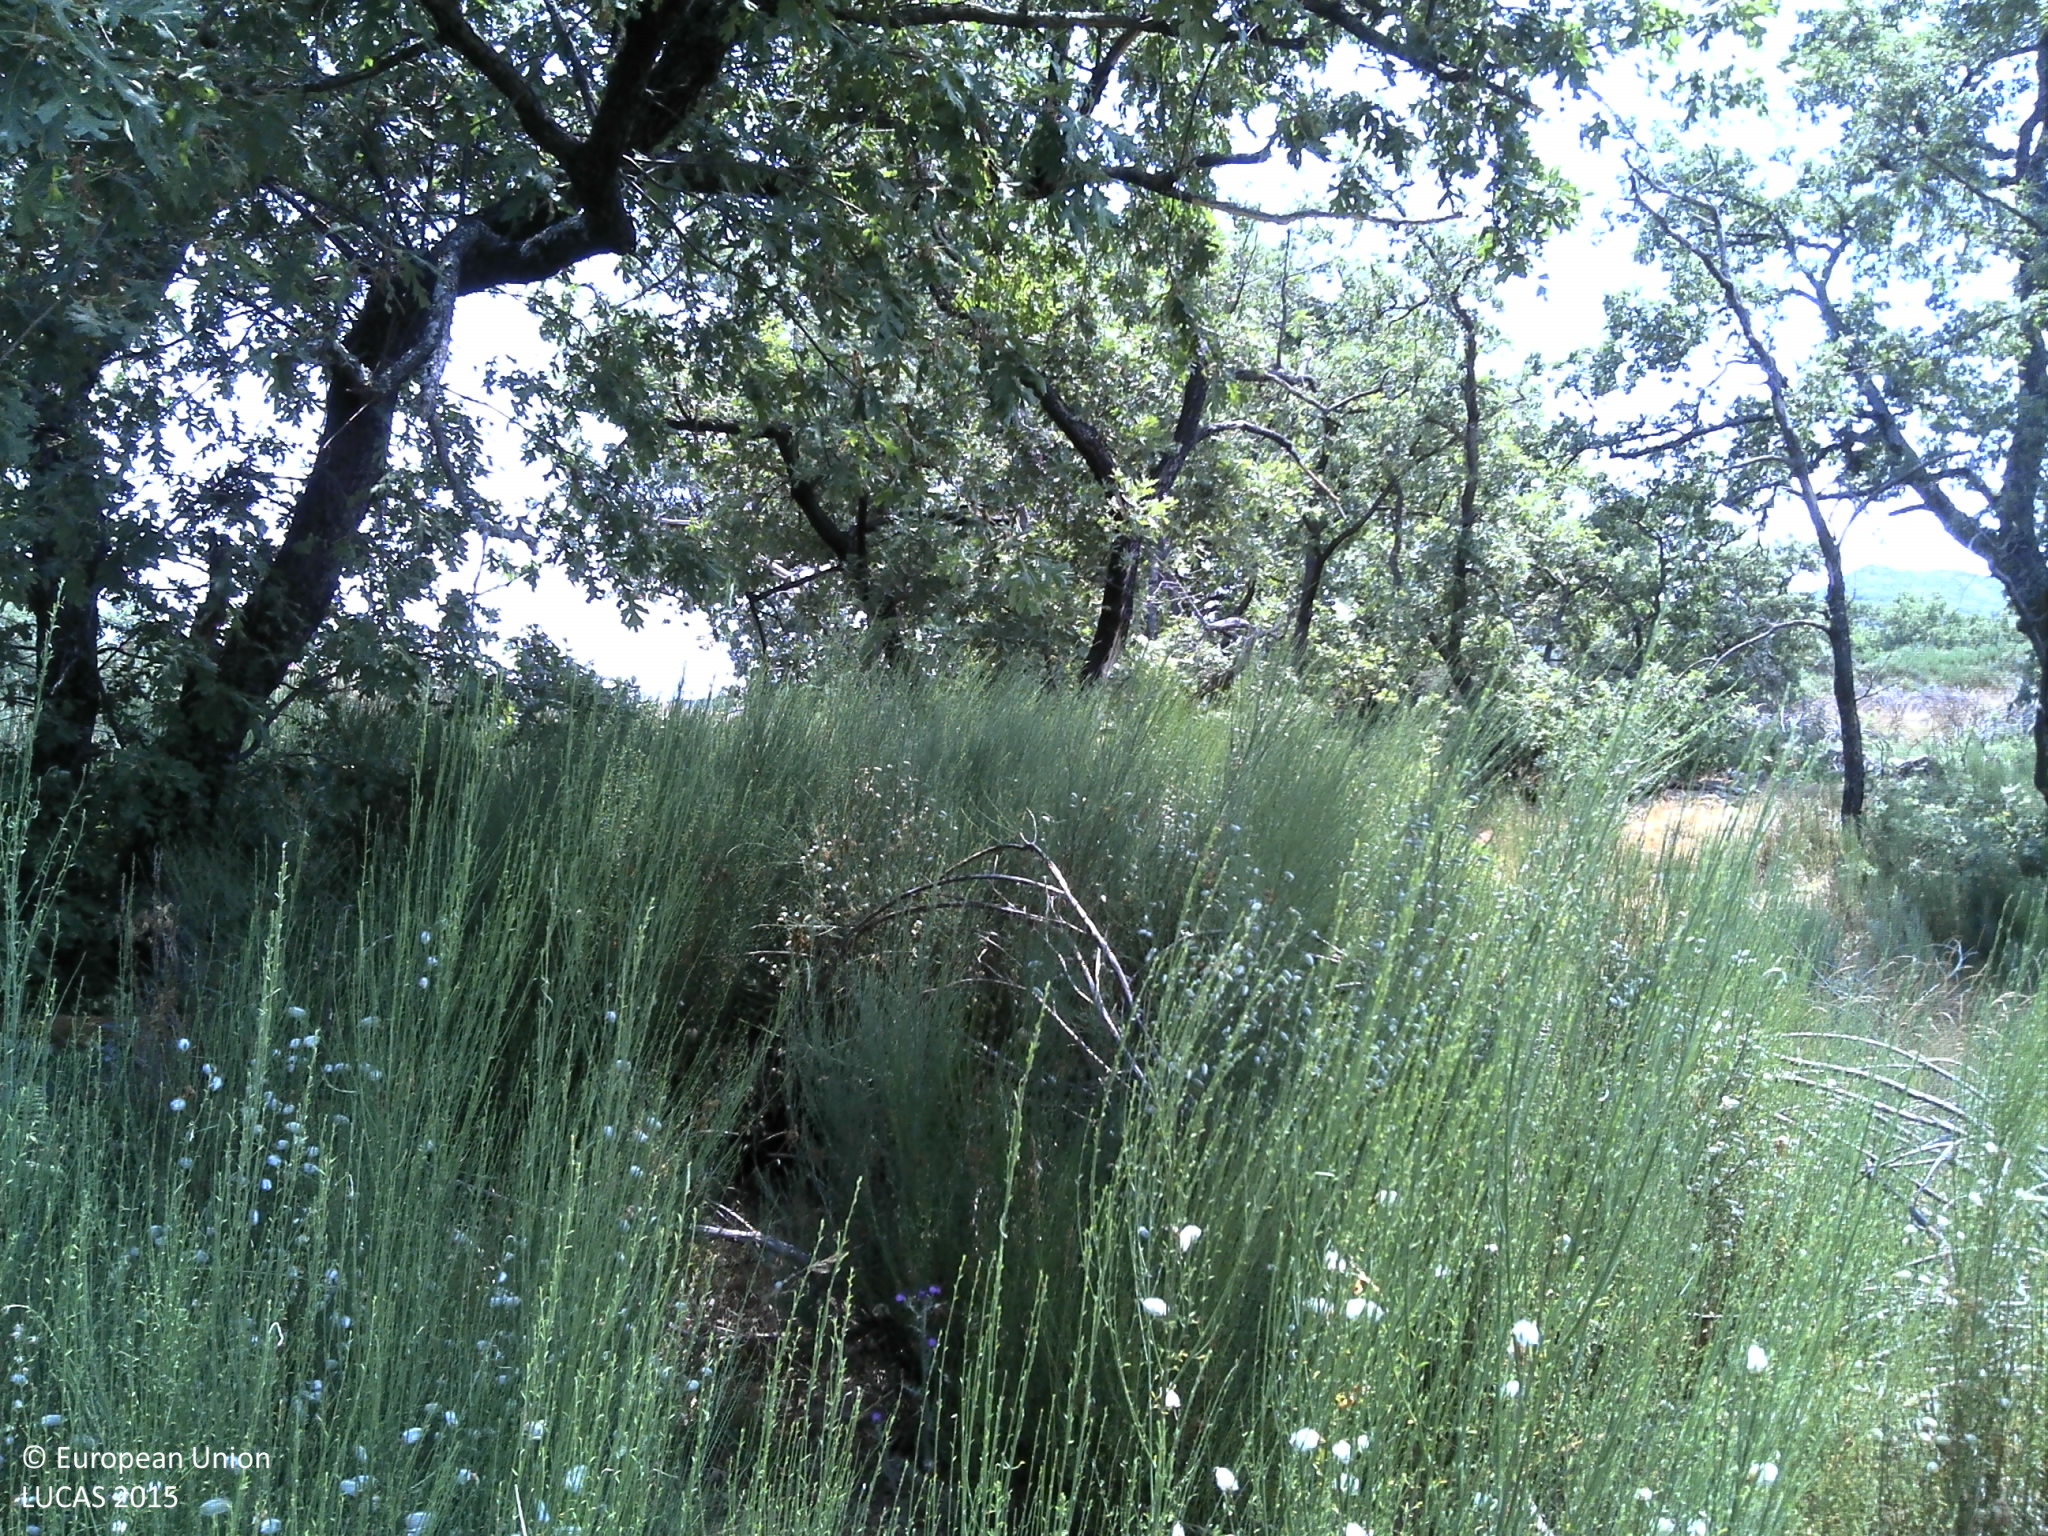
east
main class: Shrubland
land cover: Shrubland with sparse tree cover
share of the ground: > 75 %
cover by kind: shrubs 80 %, herbaceous plants 10 %, broadleaved forest trees 5 %, consolidated bare surface 5 %
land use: Semi-natural and natural areas not in use
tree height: > 5 m
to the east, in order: Shrubland with sparse tree cover; Spontaneously vegetated surfaces; Dry stone walls; Grassland without tree/shrub cover; Dry stone walls; Tracks; Shruby margins; Dry stone walls; Shrubland without tree cover; Rock outcrops; Dry stone walls; Rock outcrops; Dry stone walls; Spontaneously vegetated surfaces; Rock outcrops
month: June
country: PT
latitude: 41.4325
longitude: -7.5884
